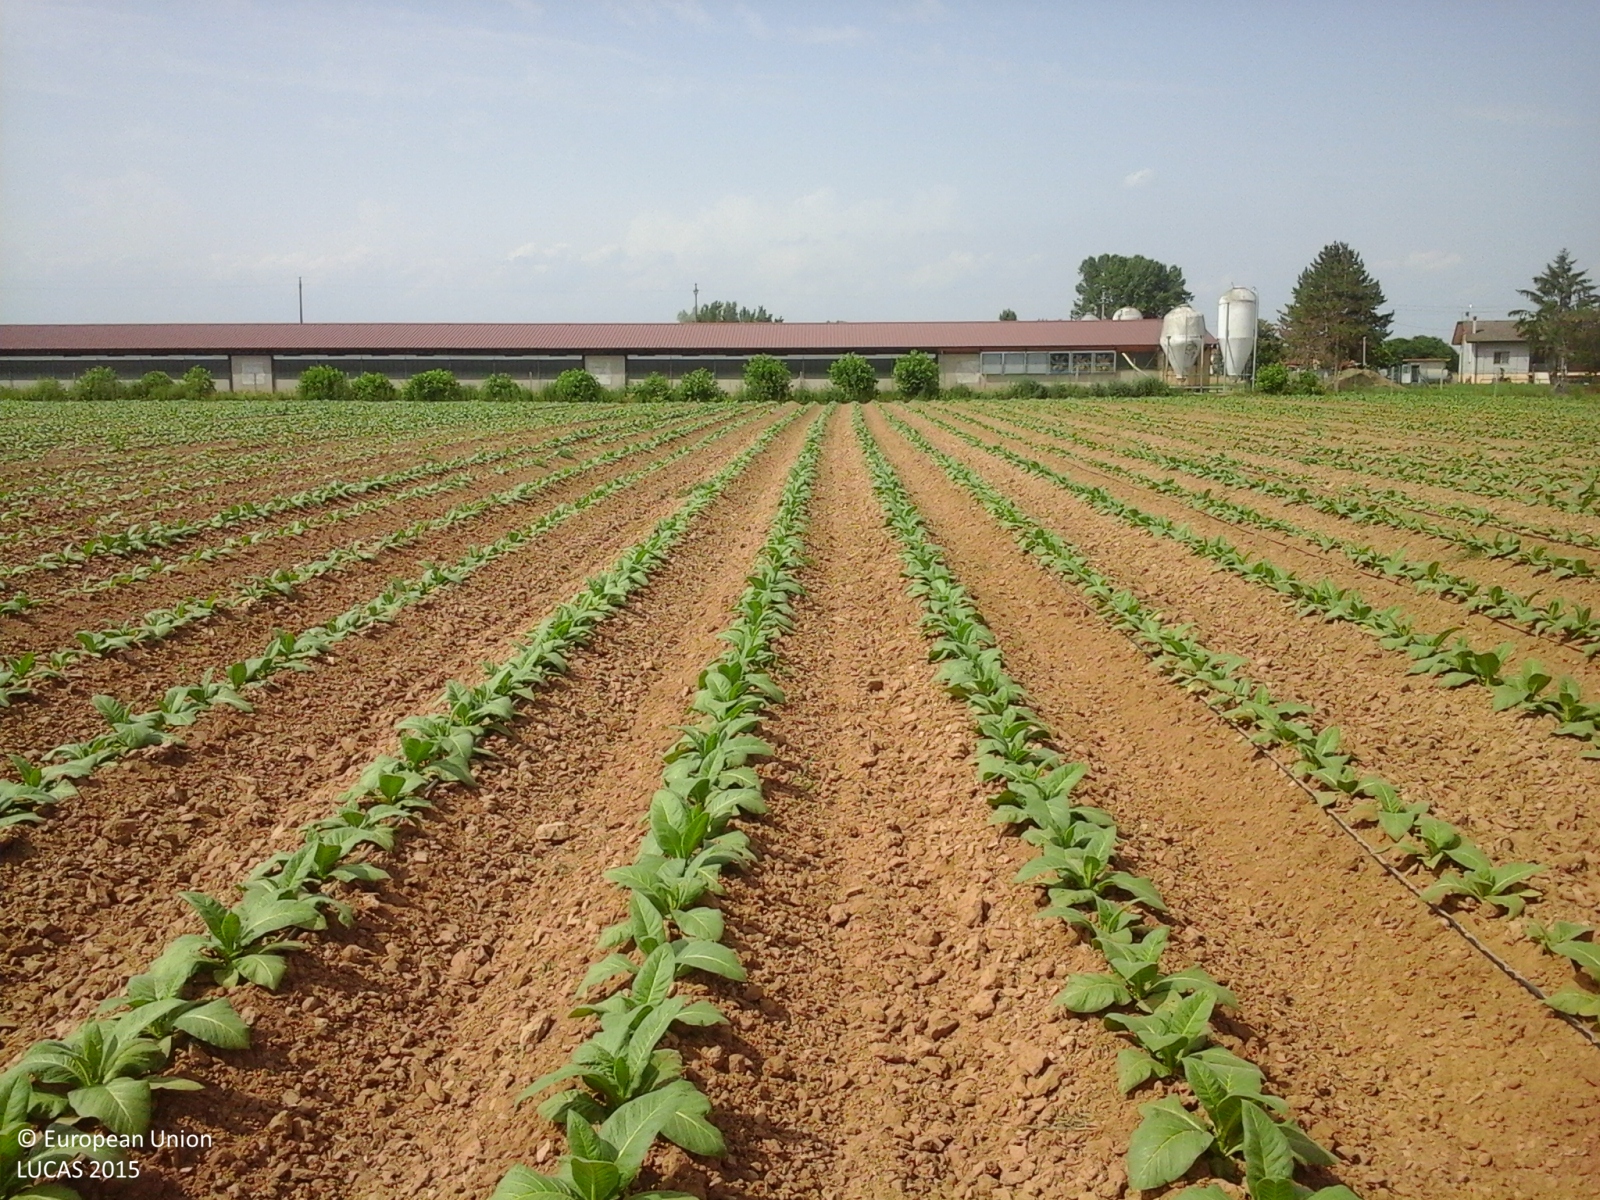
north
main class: Cropland
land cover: Tobacco
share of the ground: 10 - 25 %
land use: Agriculture (excluding fallow land and kitchen gardens)
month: June
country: IT
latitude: 45.2634
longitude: 11.1831
